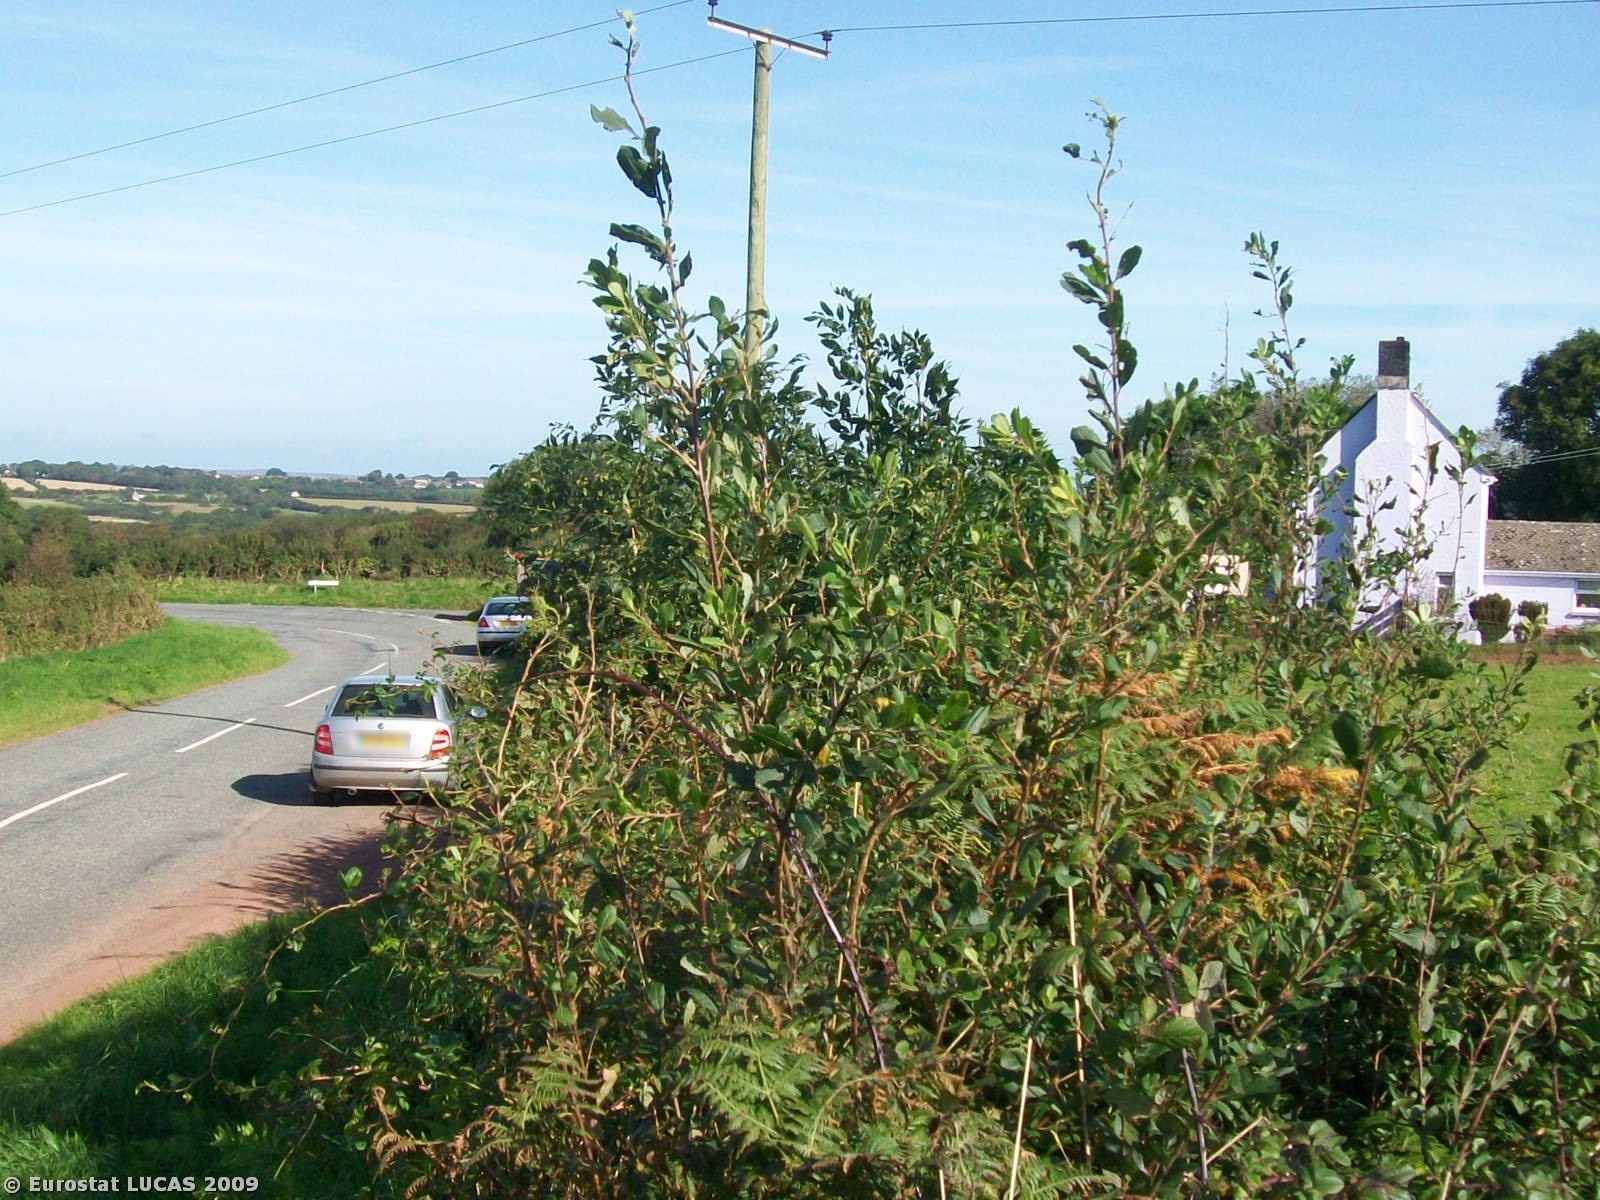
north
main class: Grassland
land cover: Grassland without tree/shrub cover
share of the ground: > 75 %
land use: Agriculture (excluding fallow land and kitchen gardens)
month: September
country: GB
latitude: 51.7297
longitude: -4.9863
